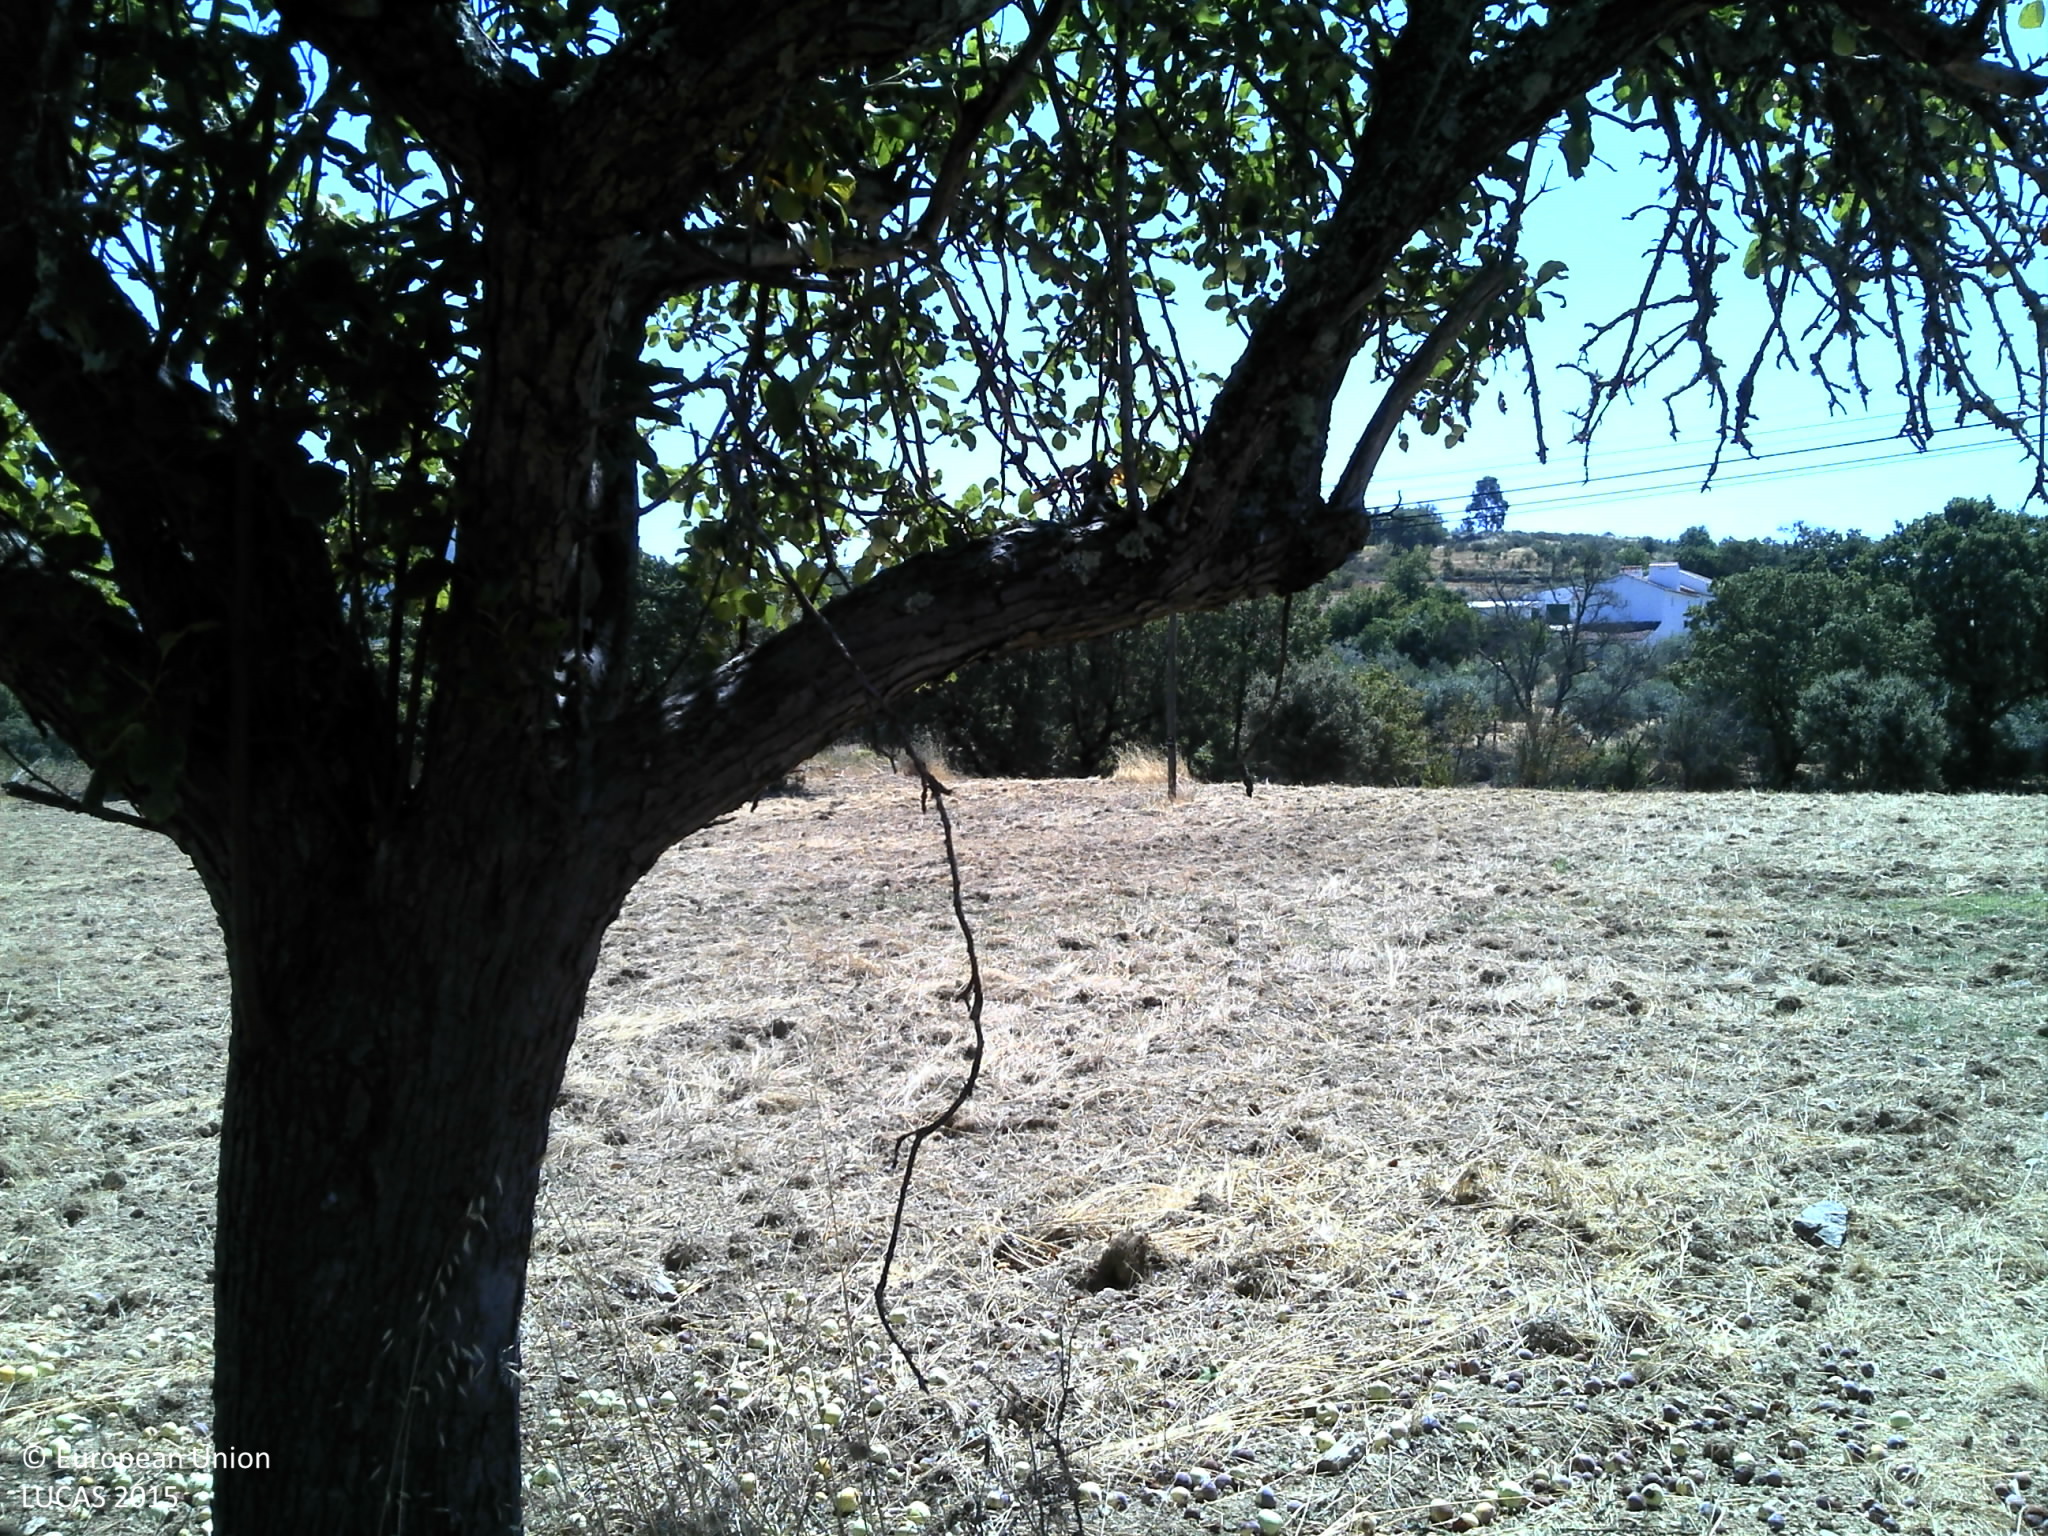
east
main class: Cropland
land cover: Apple fruit
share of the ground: 10 - 25 %
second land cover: Other bare soil
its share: > 75 %
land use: Agriculture (excluding fallow land and kitchen gardens)
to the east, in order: Apple fruit; Other bare soil; Apple fruit; Grassland without tree/shrub cover; Electric lines; Artificial constructions in urban areas; Broadleaved woodland; Olive groves; Electric lines; Olive groves; Rock outcrops; Olive groves; Other bare soil; Shruby margins; Rivers and streams; Shruby margins; Broadleaved woodland; Dry stone walls; Electric lines; Paved roads, cycling and walking lanes; Dry stone walls; Fences; Olive groves; Dry stone walls; Olive groves; Broadleaved woodland; Fences; Broadleaved woodland
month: August
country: PT
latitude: 39.3646
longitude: -7.3936
